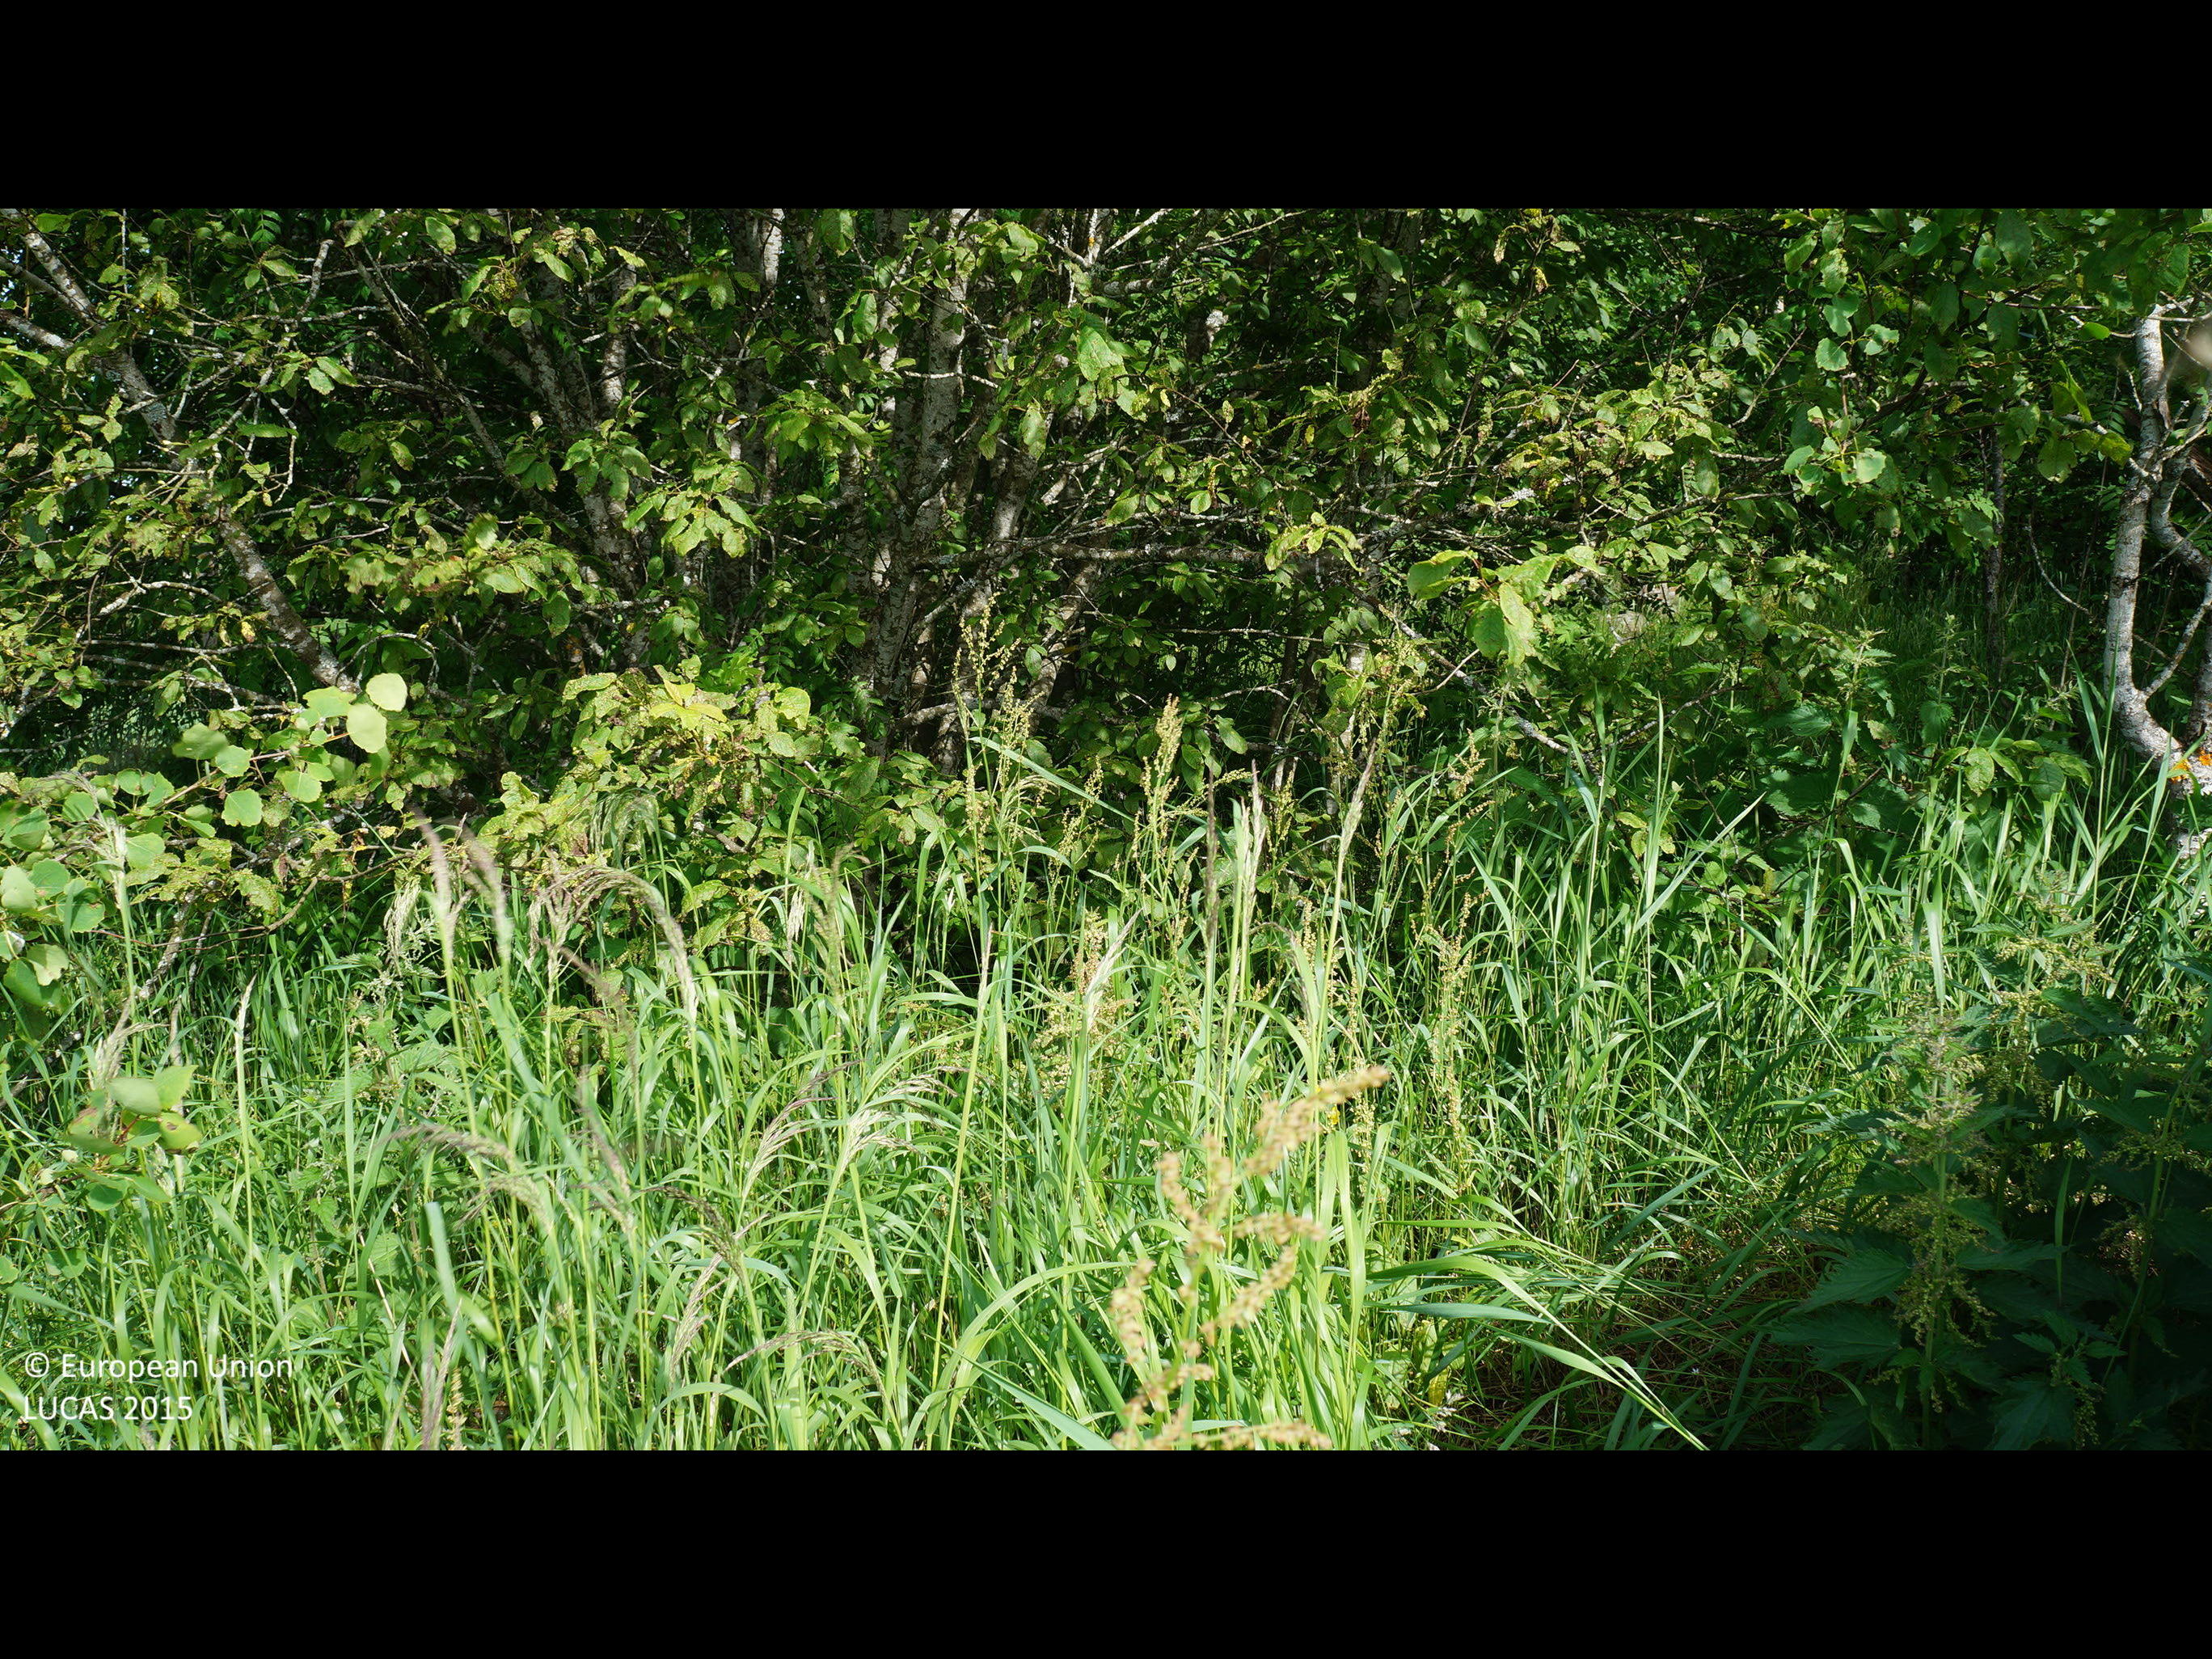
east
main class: Cropland
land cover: Temporary grasslands
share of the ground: > 75 %
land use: Agriculture (excluding fallow land and kitchen gardens)
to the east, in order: Temporary grasslands; Ditches and canals; Temporary grasslands; Shruby margins; Broadleaved woodland; Pine dominated mixed woodland; Tracks; Pine dominated mixed woodland; Tracks; Pine dominated mixed woodland; Broadleaved woodland
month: July
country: FI
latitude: 64.1851
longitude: 24.3328
